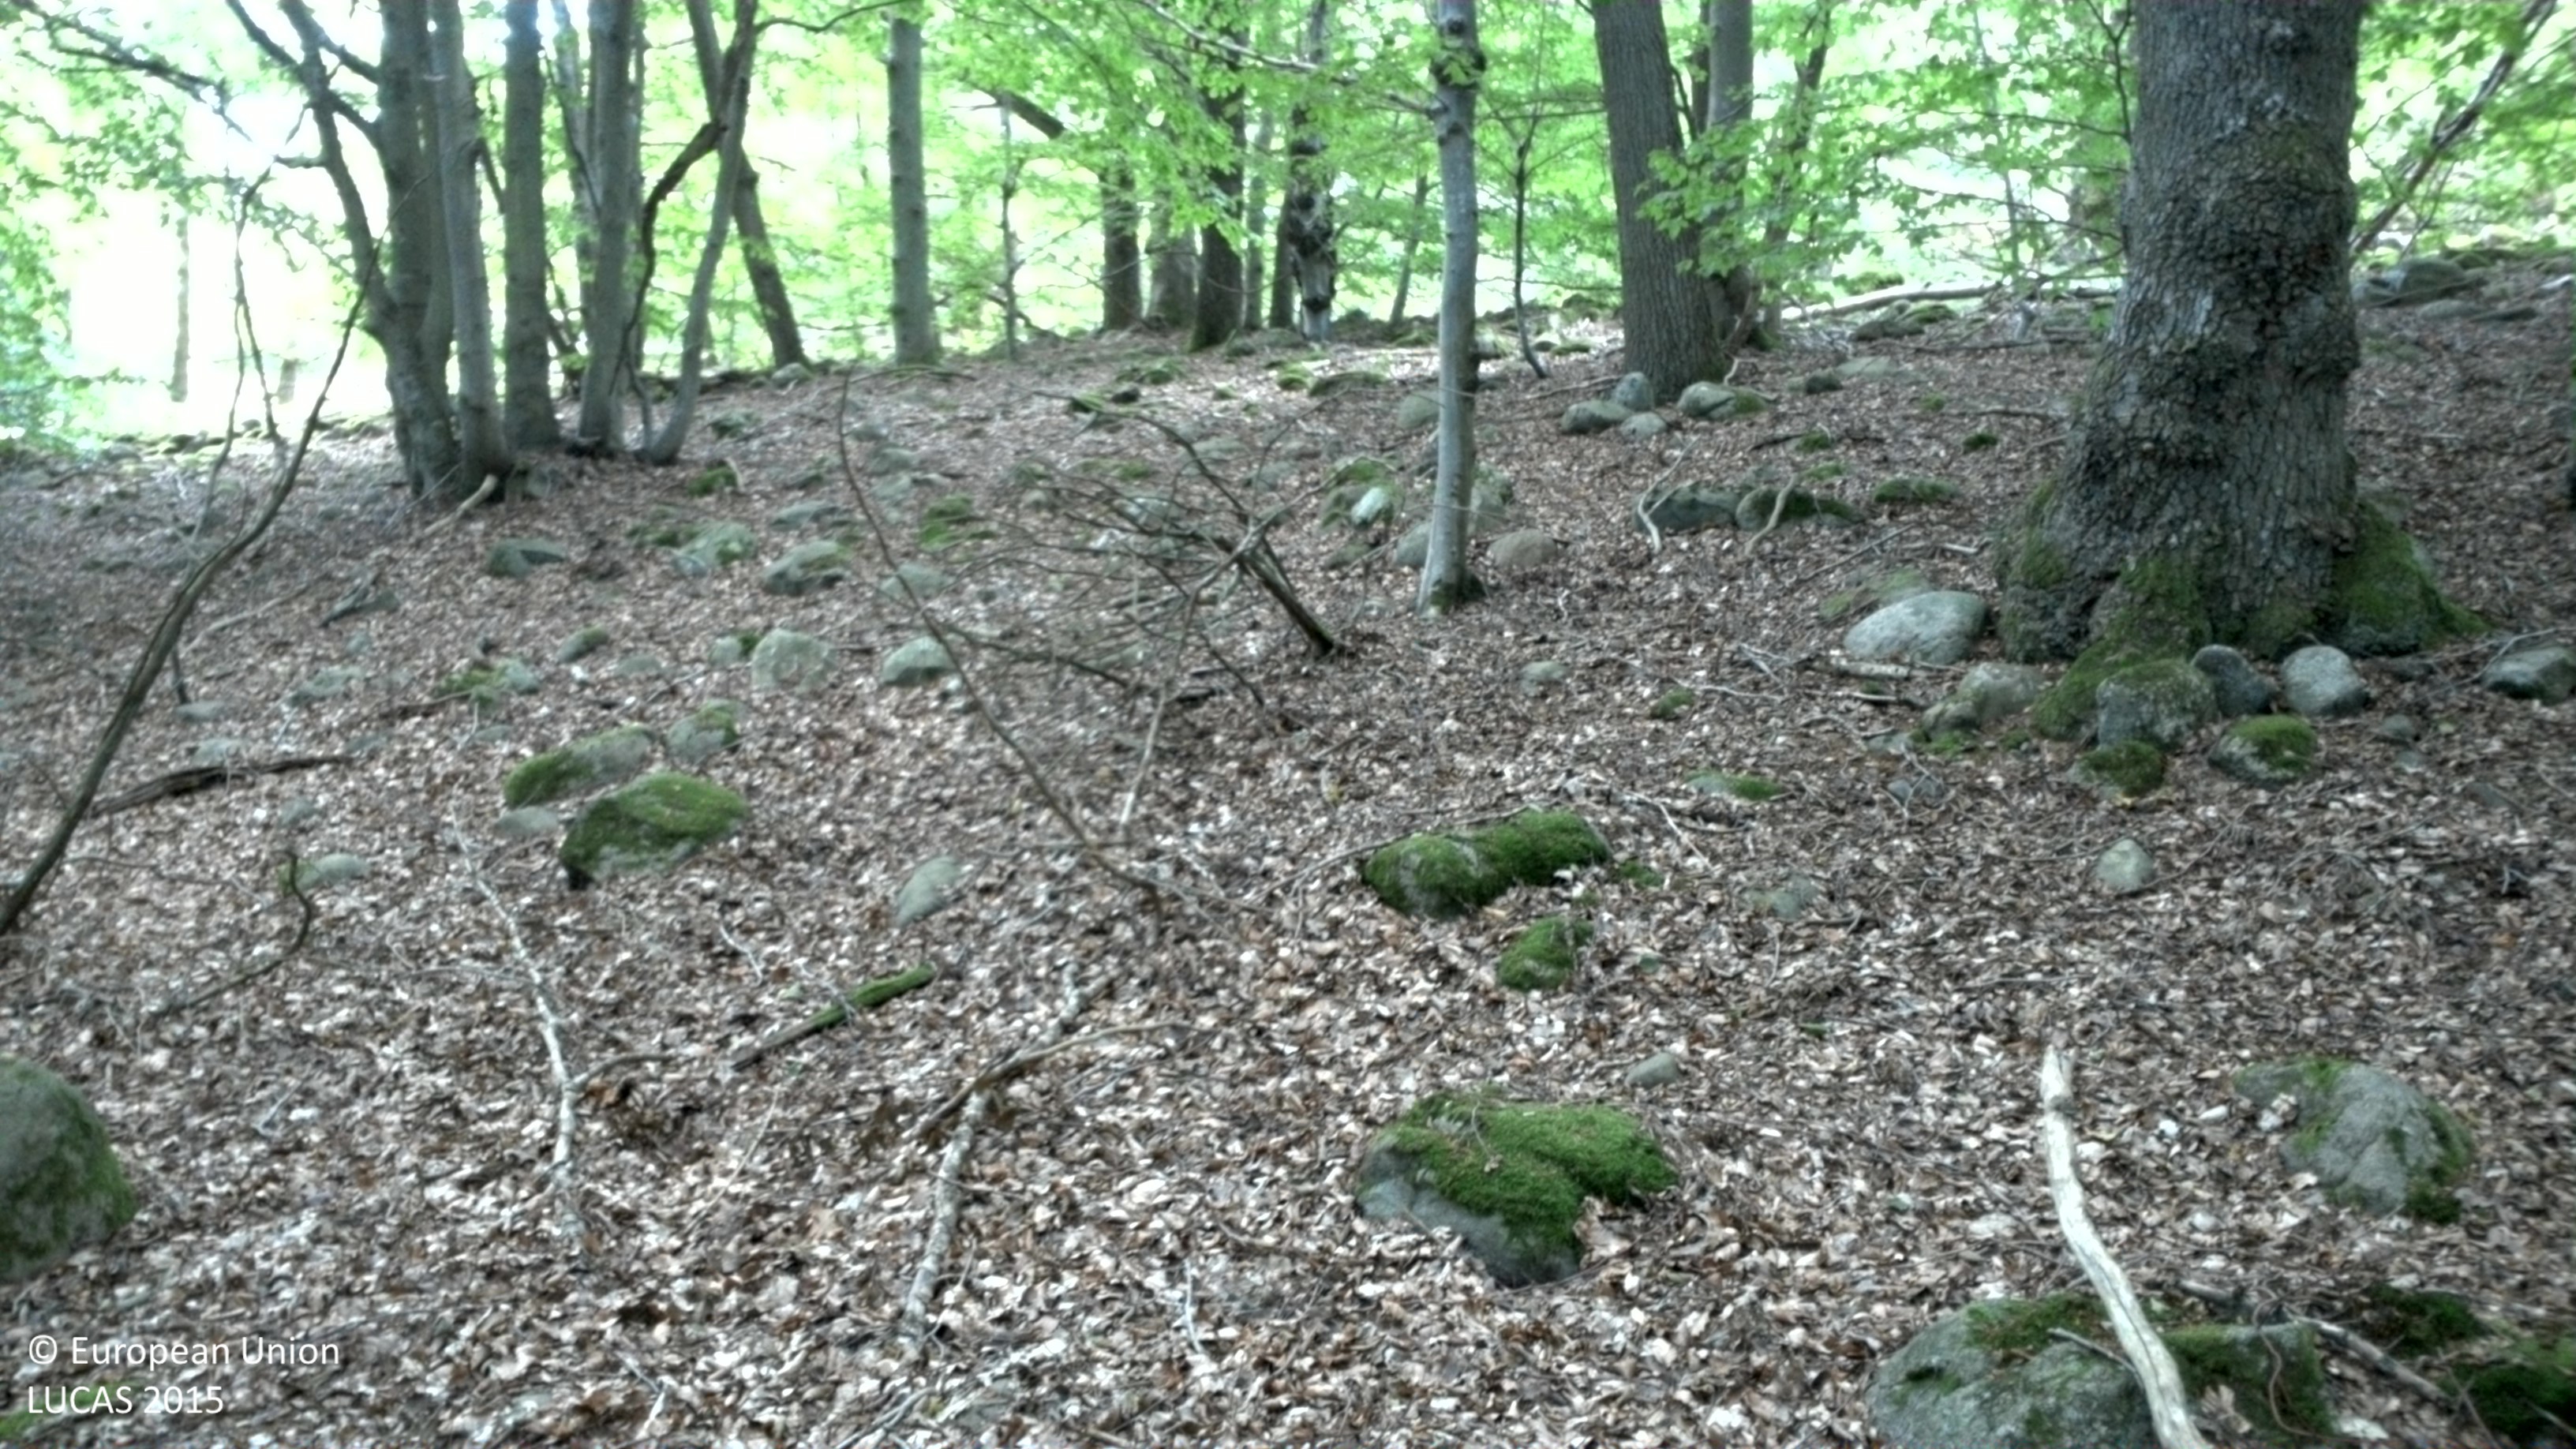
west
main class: Woodland
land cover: Broadleaved woodland
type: beech forest
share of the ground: > 75 %
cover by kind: broadleaved forest trees 75 %, consolidated bare surface 5 %
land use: Amenities, museums, leisure
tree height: > 5 m
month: September
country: SE
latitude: 56.0273
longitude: 14.7643
